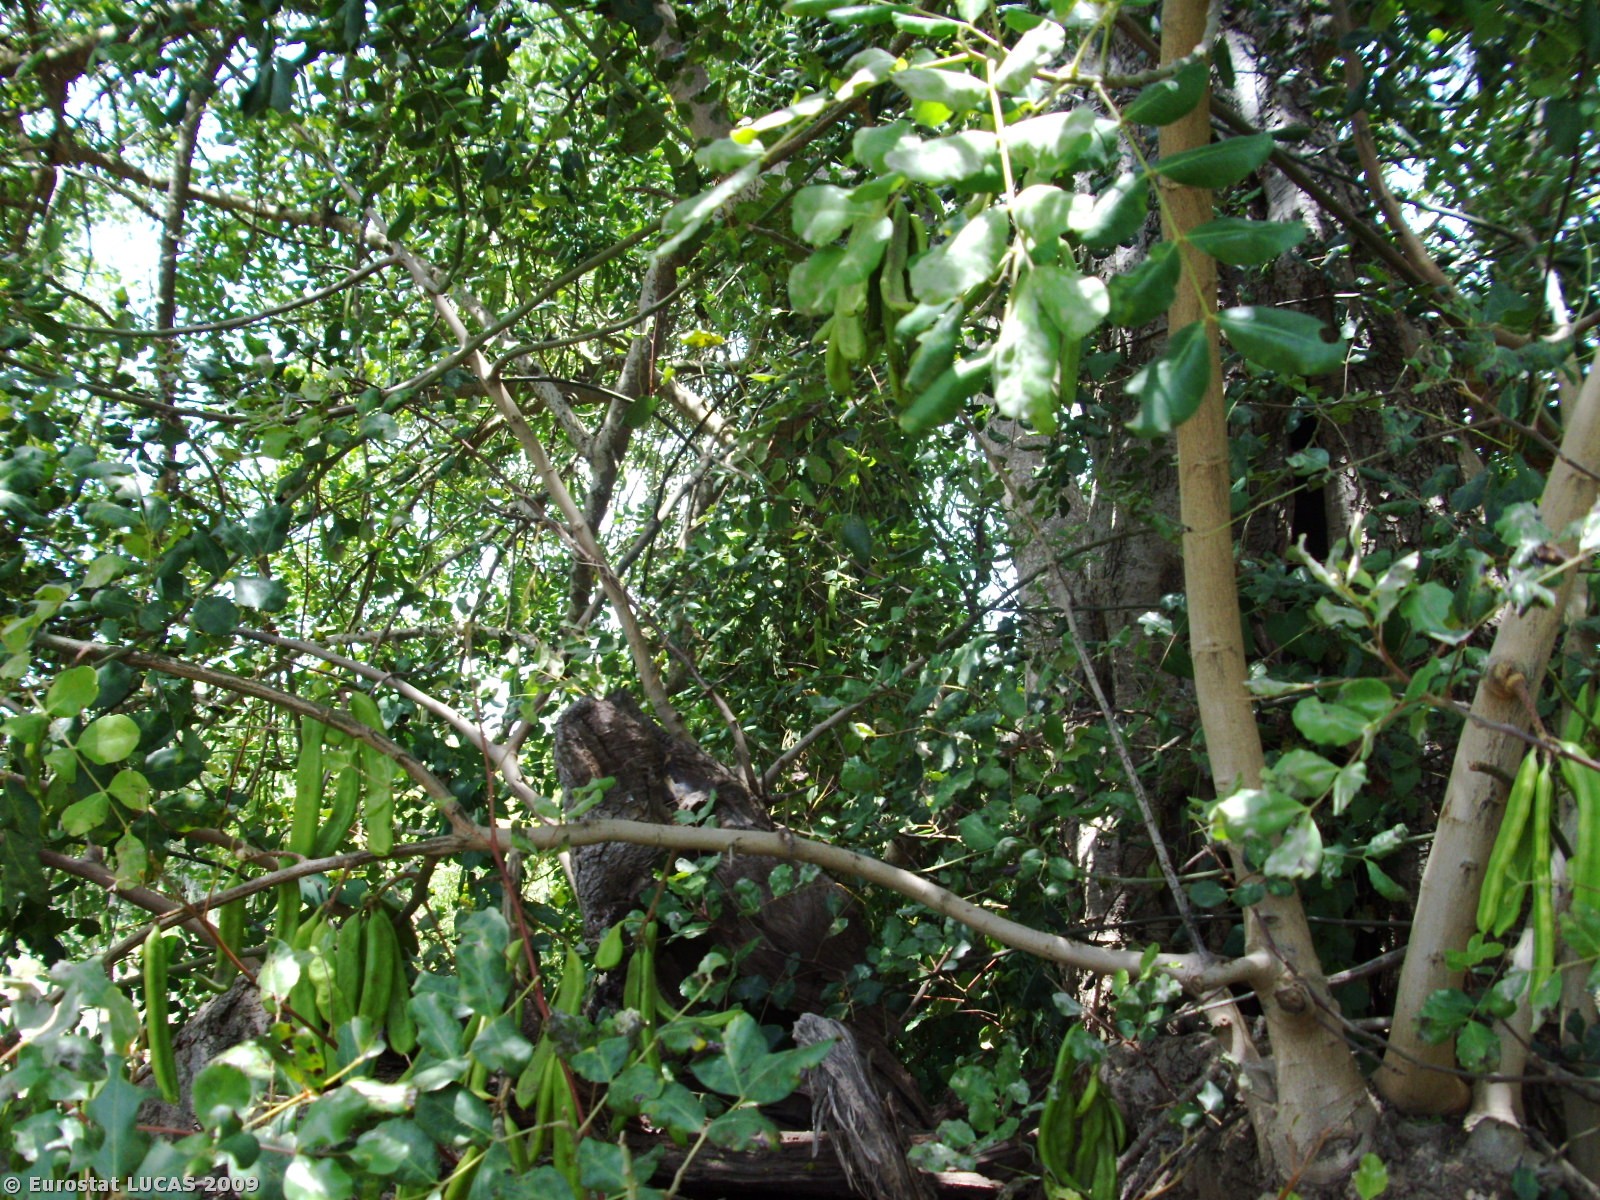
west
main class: Cropland
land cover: Permanent industrial crops
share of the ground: 25 - 50 %
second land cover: Spontaneously vegetated surfaces
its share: 50 - 75 %
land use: Fallow land
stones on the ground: < 10 %
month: May
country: PT
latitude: 37.1610
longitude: -8.4810
